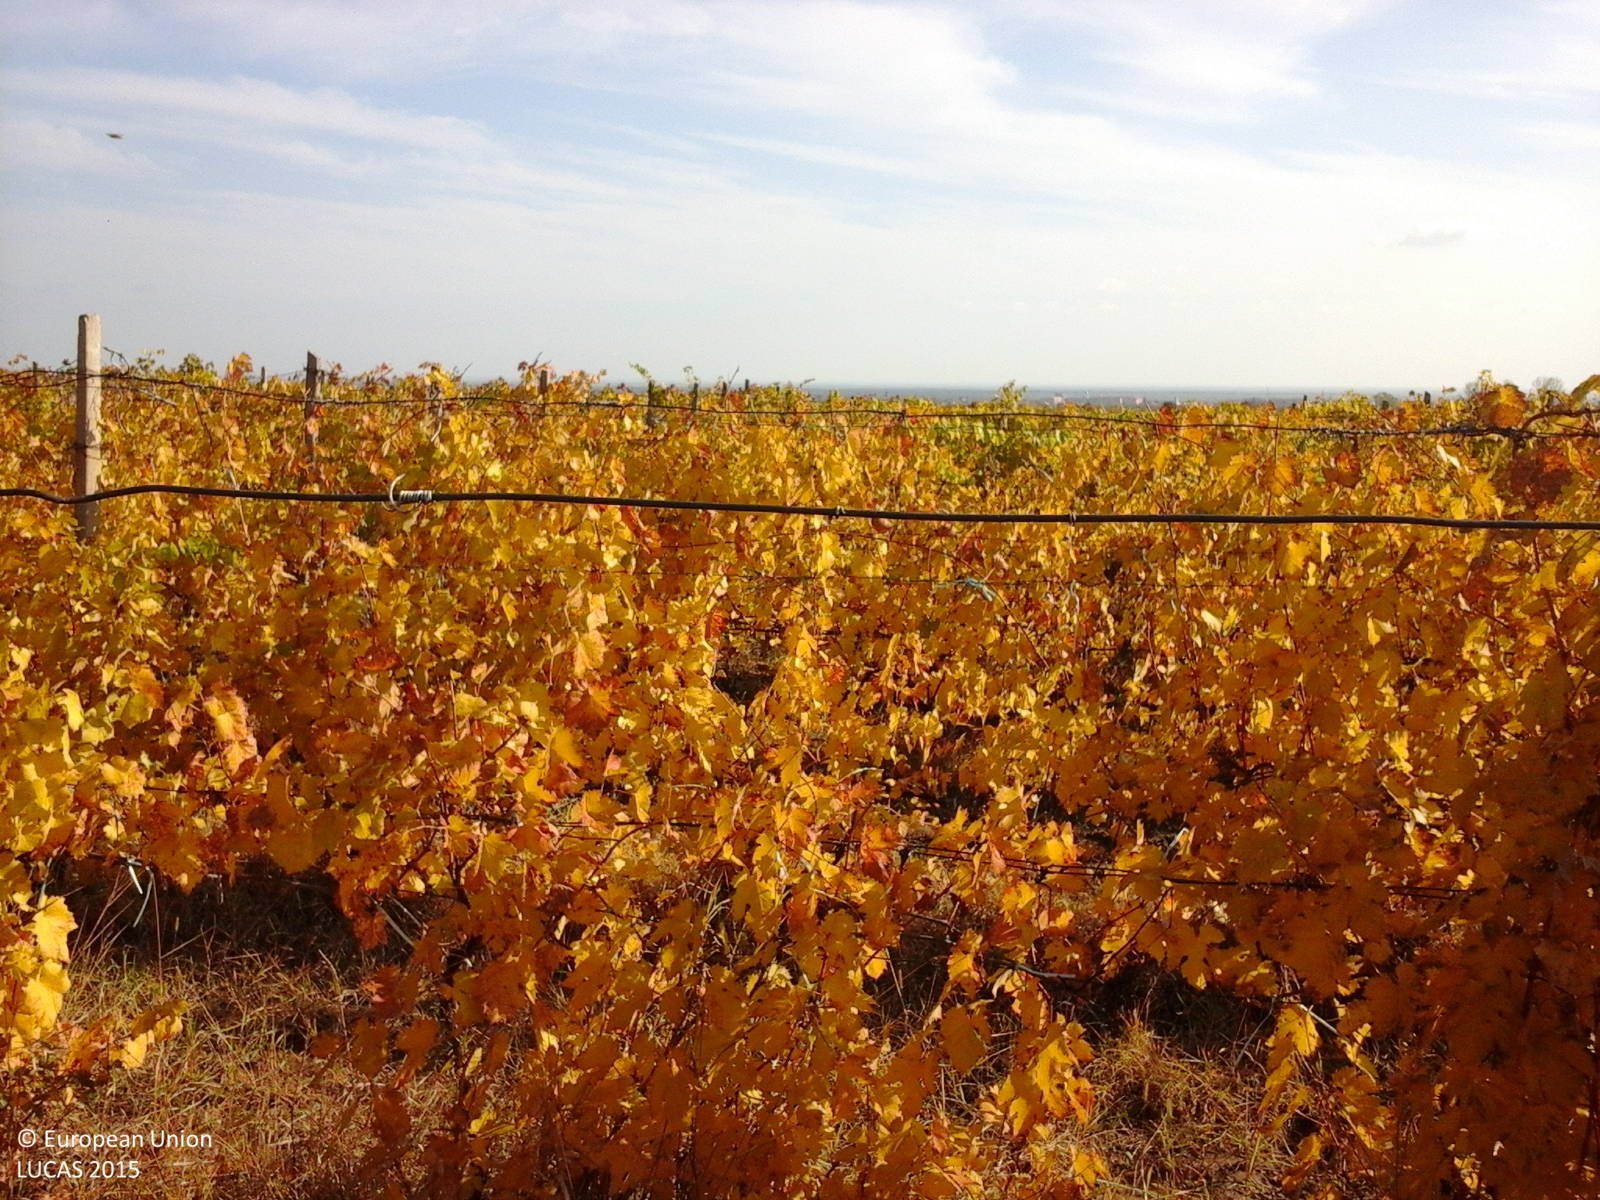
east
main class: Cropland
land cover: Vineyards
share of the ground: > 75 %
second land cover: Other bare soil
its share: > 75 %
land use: Agriculture (excluding fallow land and kitchen gardens)
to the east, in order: Vineyards; Other bare soil; Tracks; Grass margins; Vineyards
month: October
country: RO
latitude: 45.5690
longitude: 27.0944
